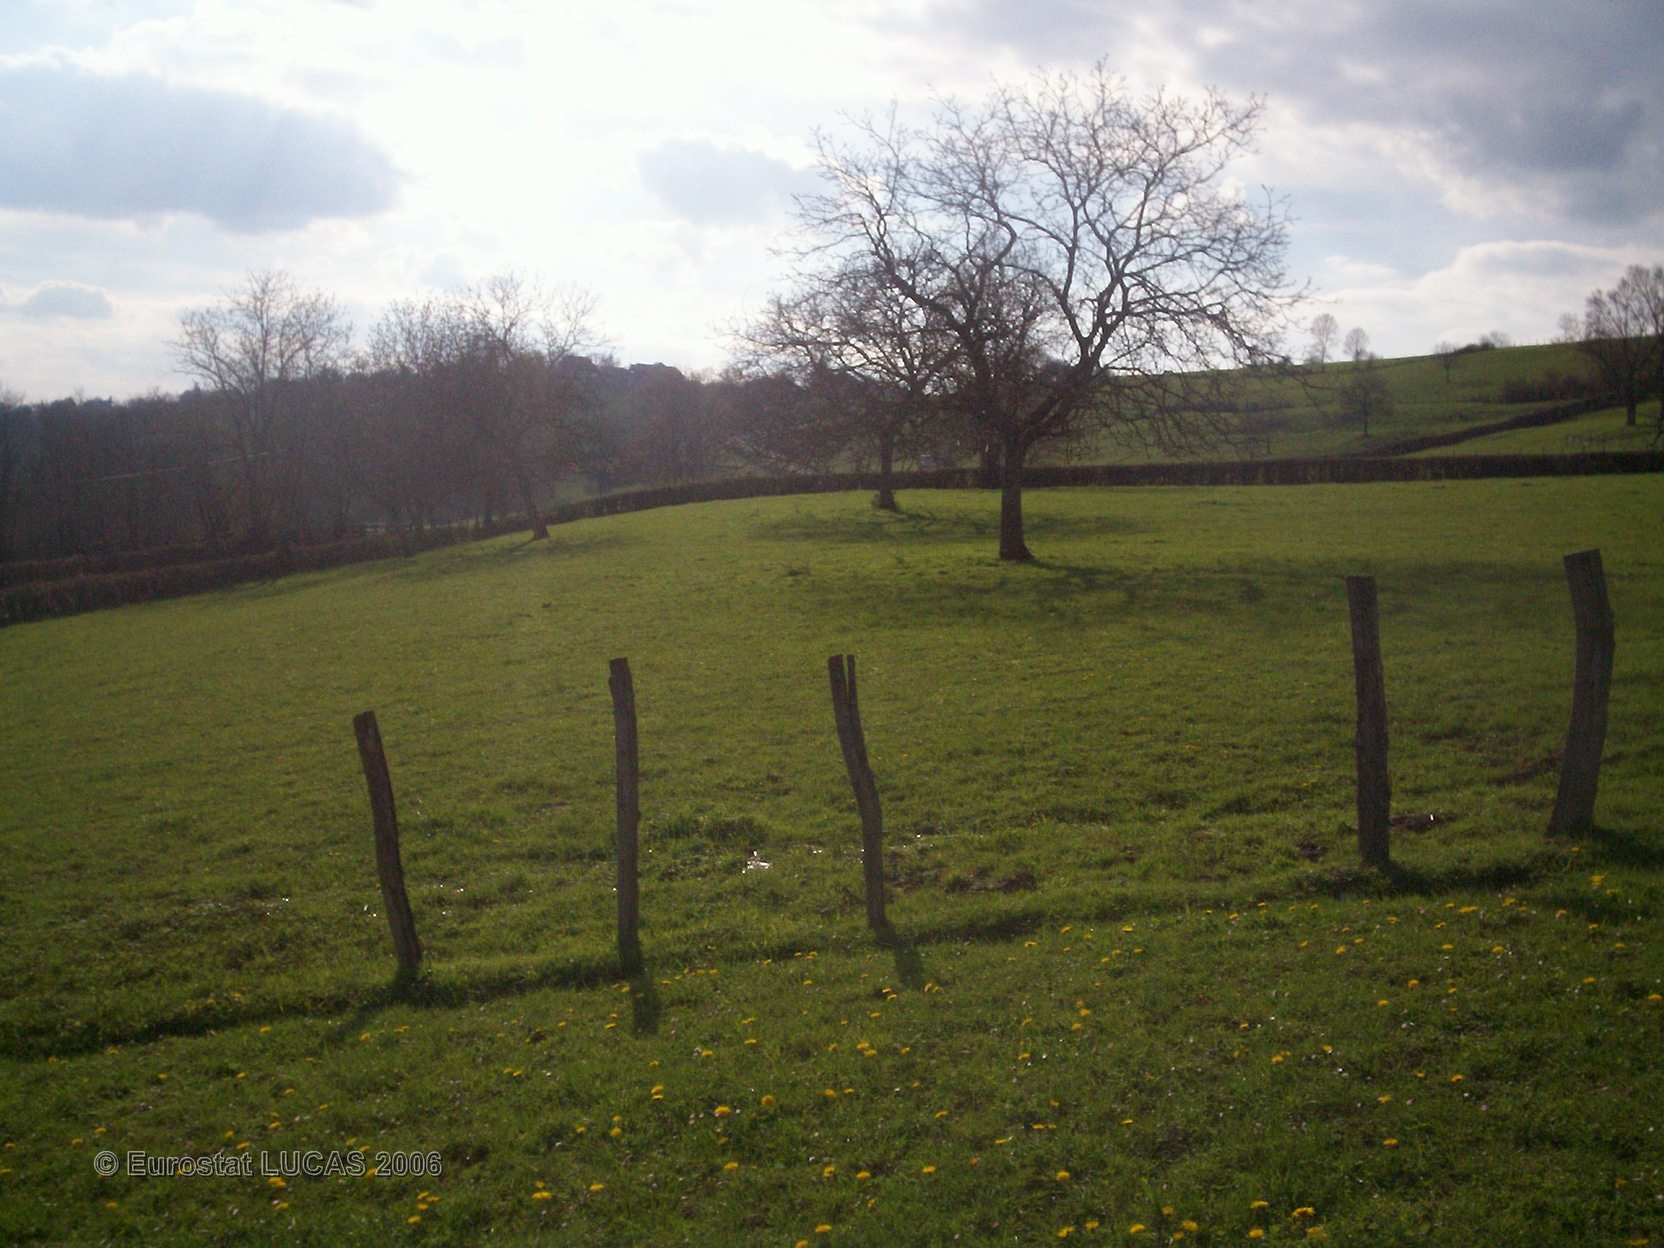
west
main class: Grassland
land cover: Grassland without tree/shrub cover
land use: Agriculture (excluding fallow land and kitchen gardens)
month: April
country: FR
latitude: 46.2260
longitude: 4.1280
